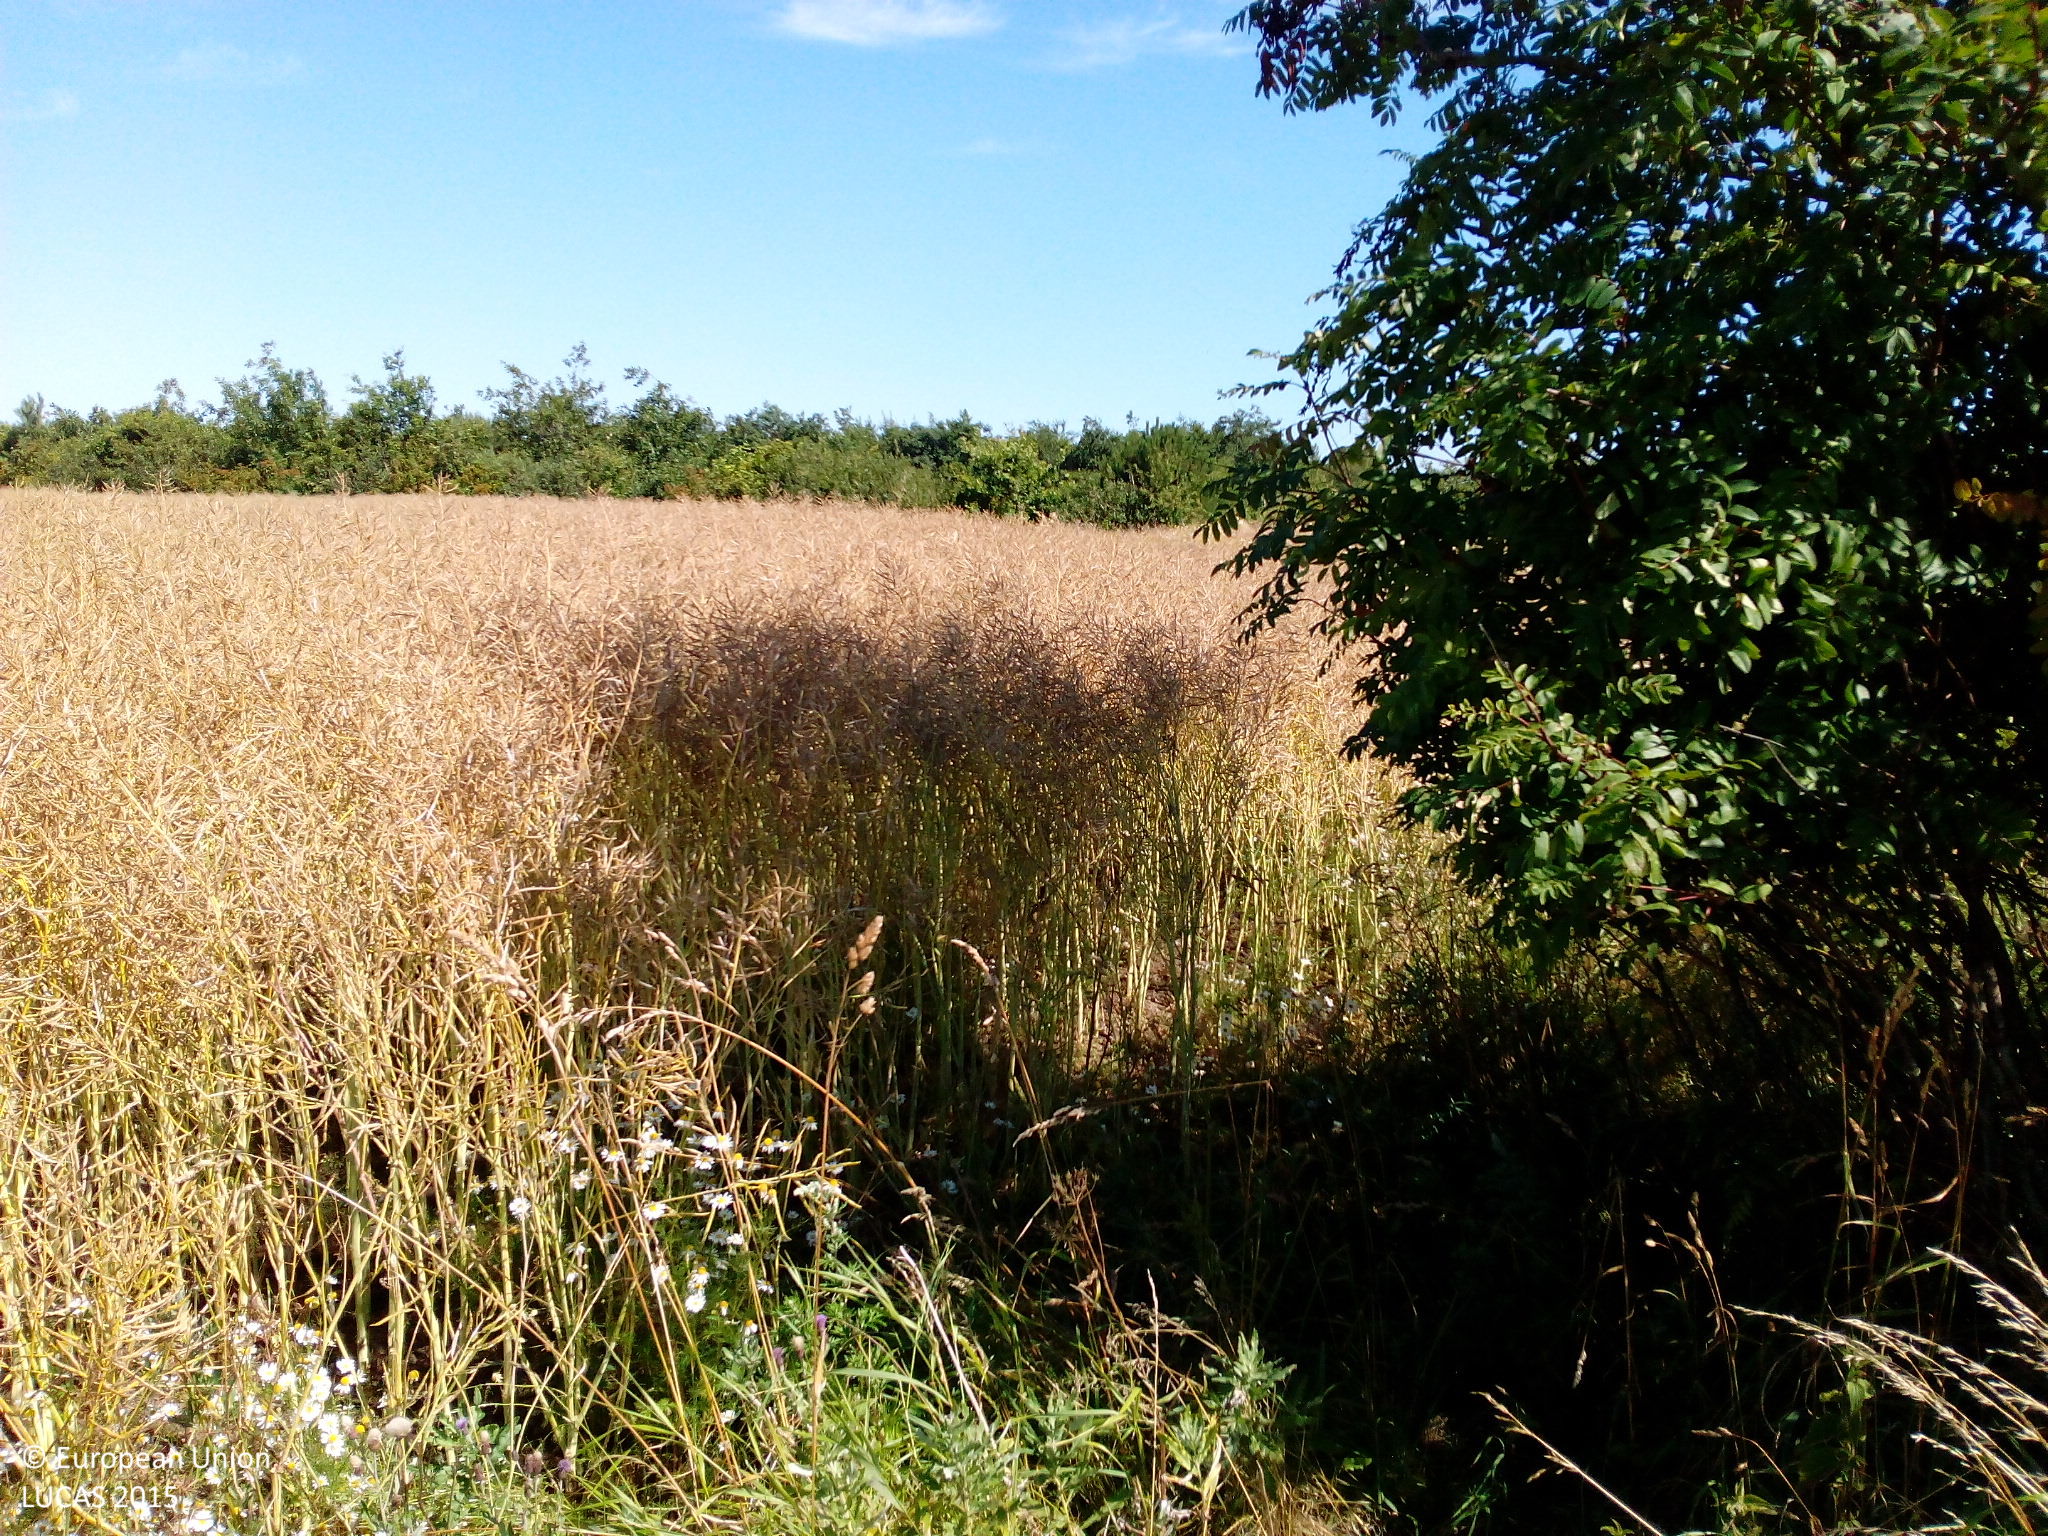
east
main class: Cropland
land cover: Rape and turnip rape
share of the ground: > 75 %
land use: Agriculture (excluding fallow land and kitchen gardens)
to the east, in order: Rape and turnip rape; Broadleaved woodland; Common wheat; Shruby margins; Broadleaved woodland; Maize; Spontaneously vegetated surfaces; Broadleaved woodland; Common wheat
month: August
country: DK
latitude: 55.5999
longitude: 11.7918
